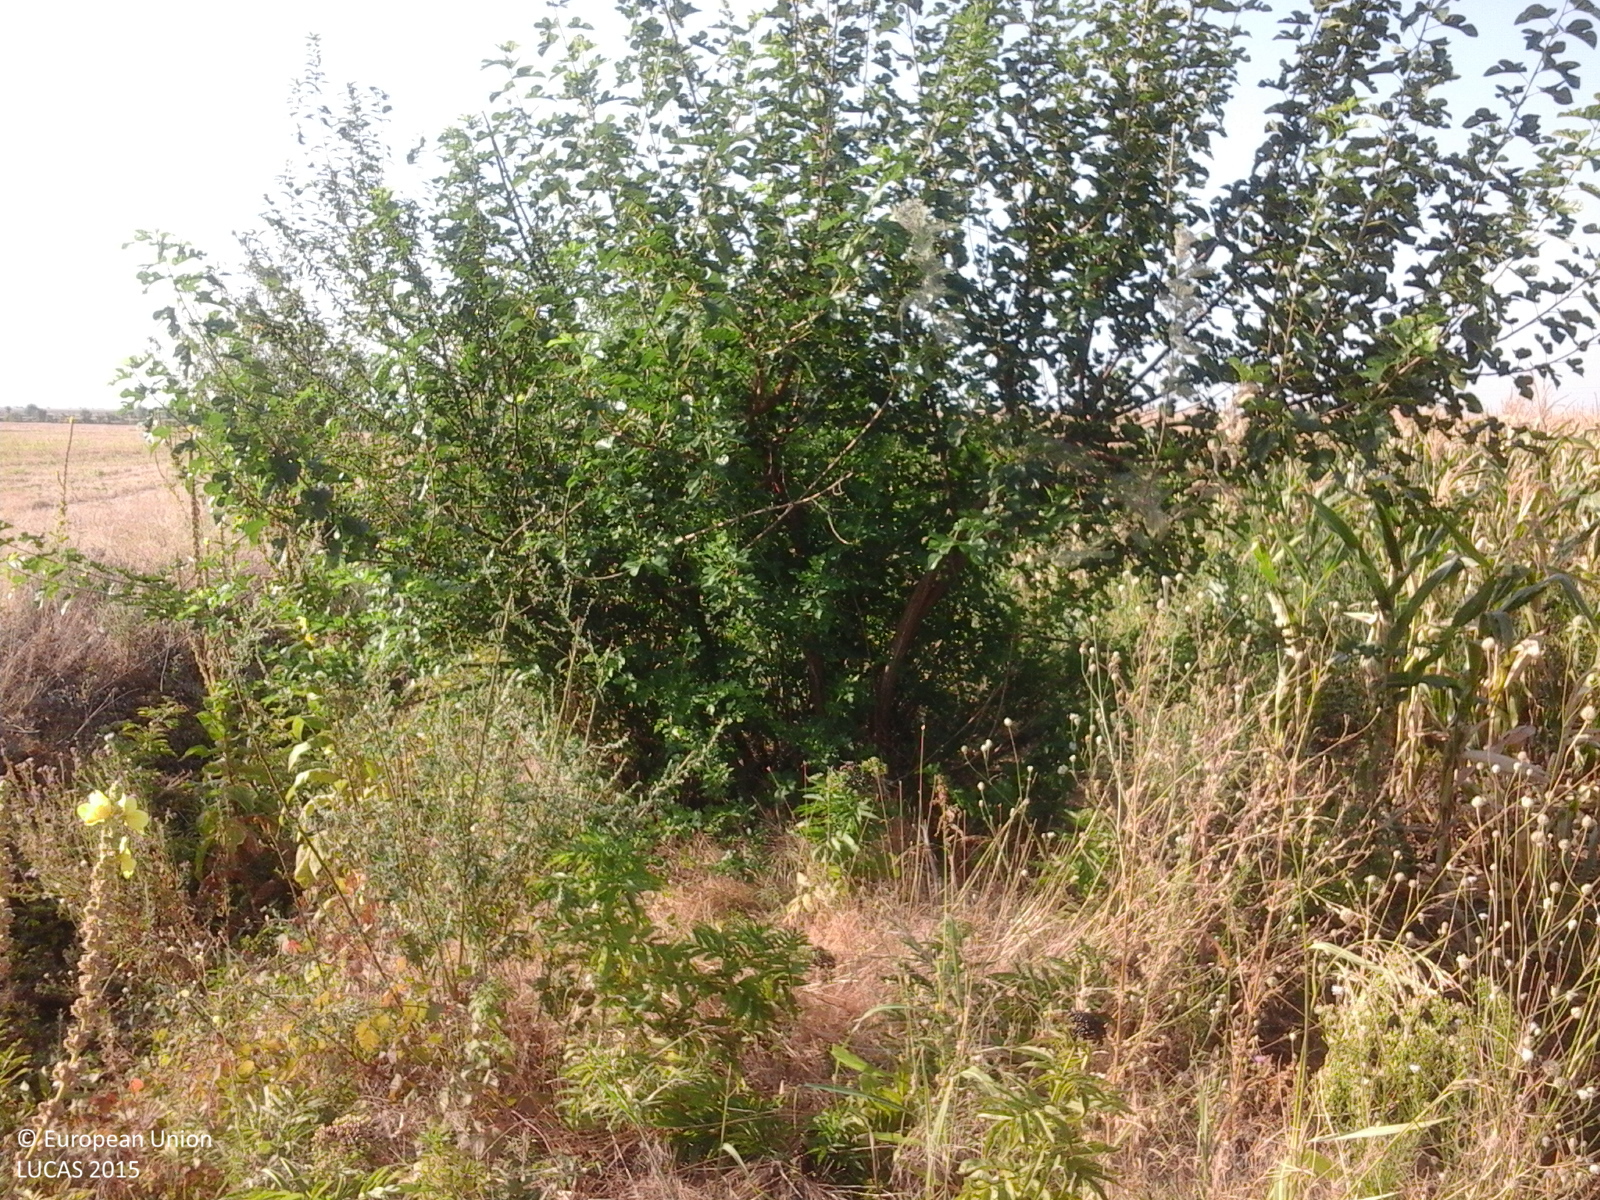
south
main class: Cropland
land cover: Maize
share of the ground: > 75 %
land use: Agriculture (excluding fallow land and kitchen gardens)
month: August
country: RO
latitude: 43.9941
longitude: 23.0732
